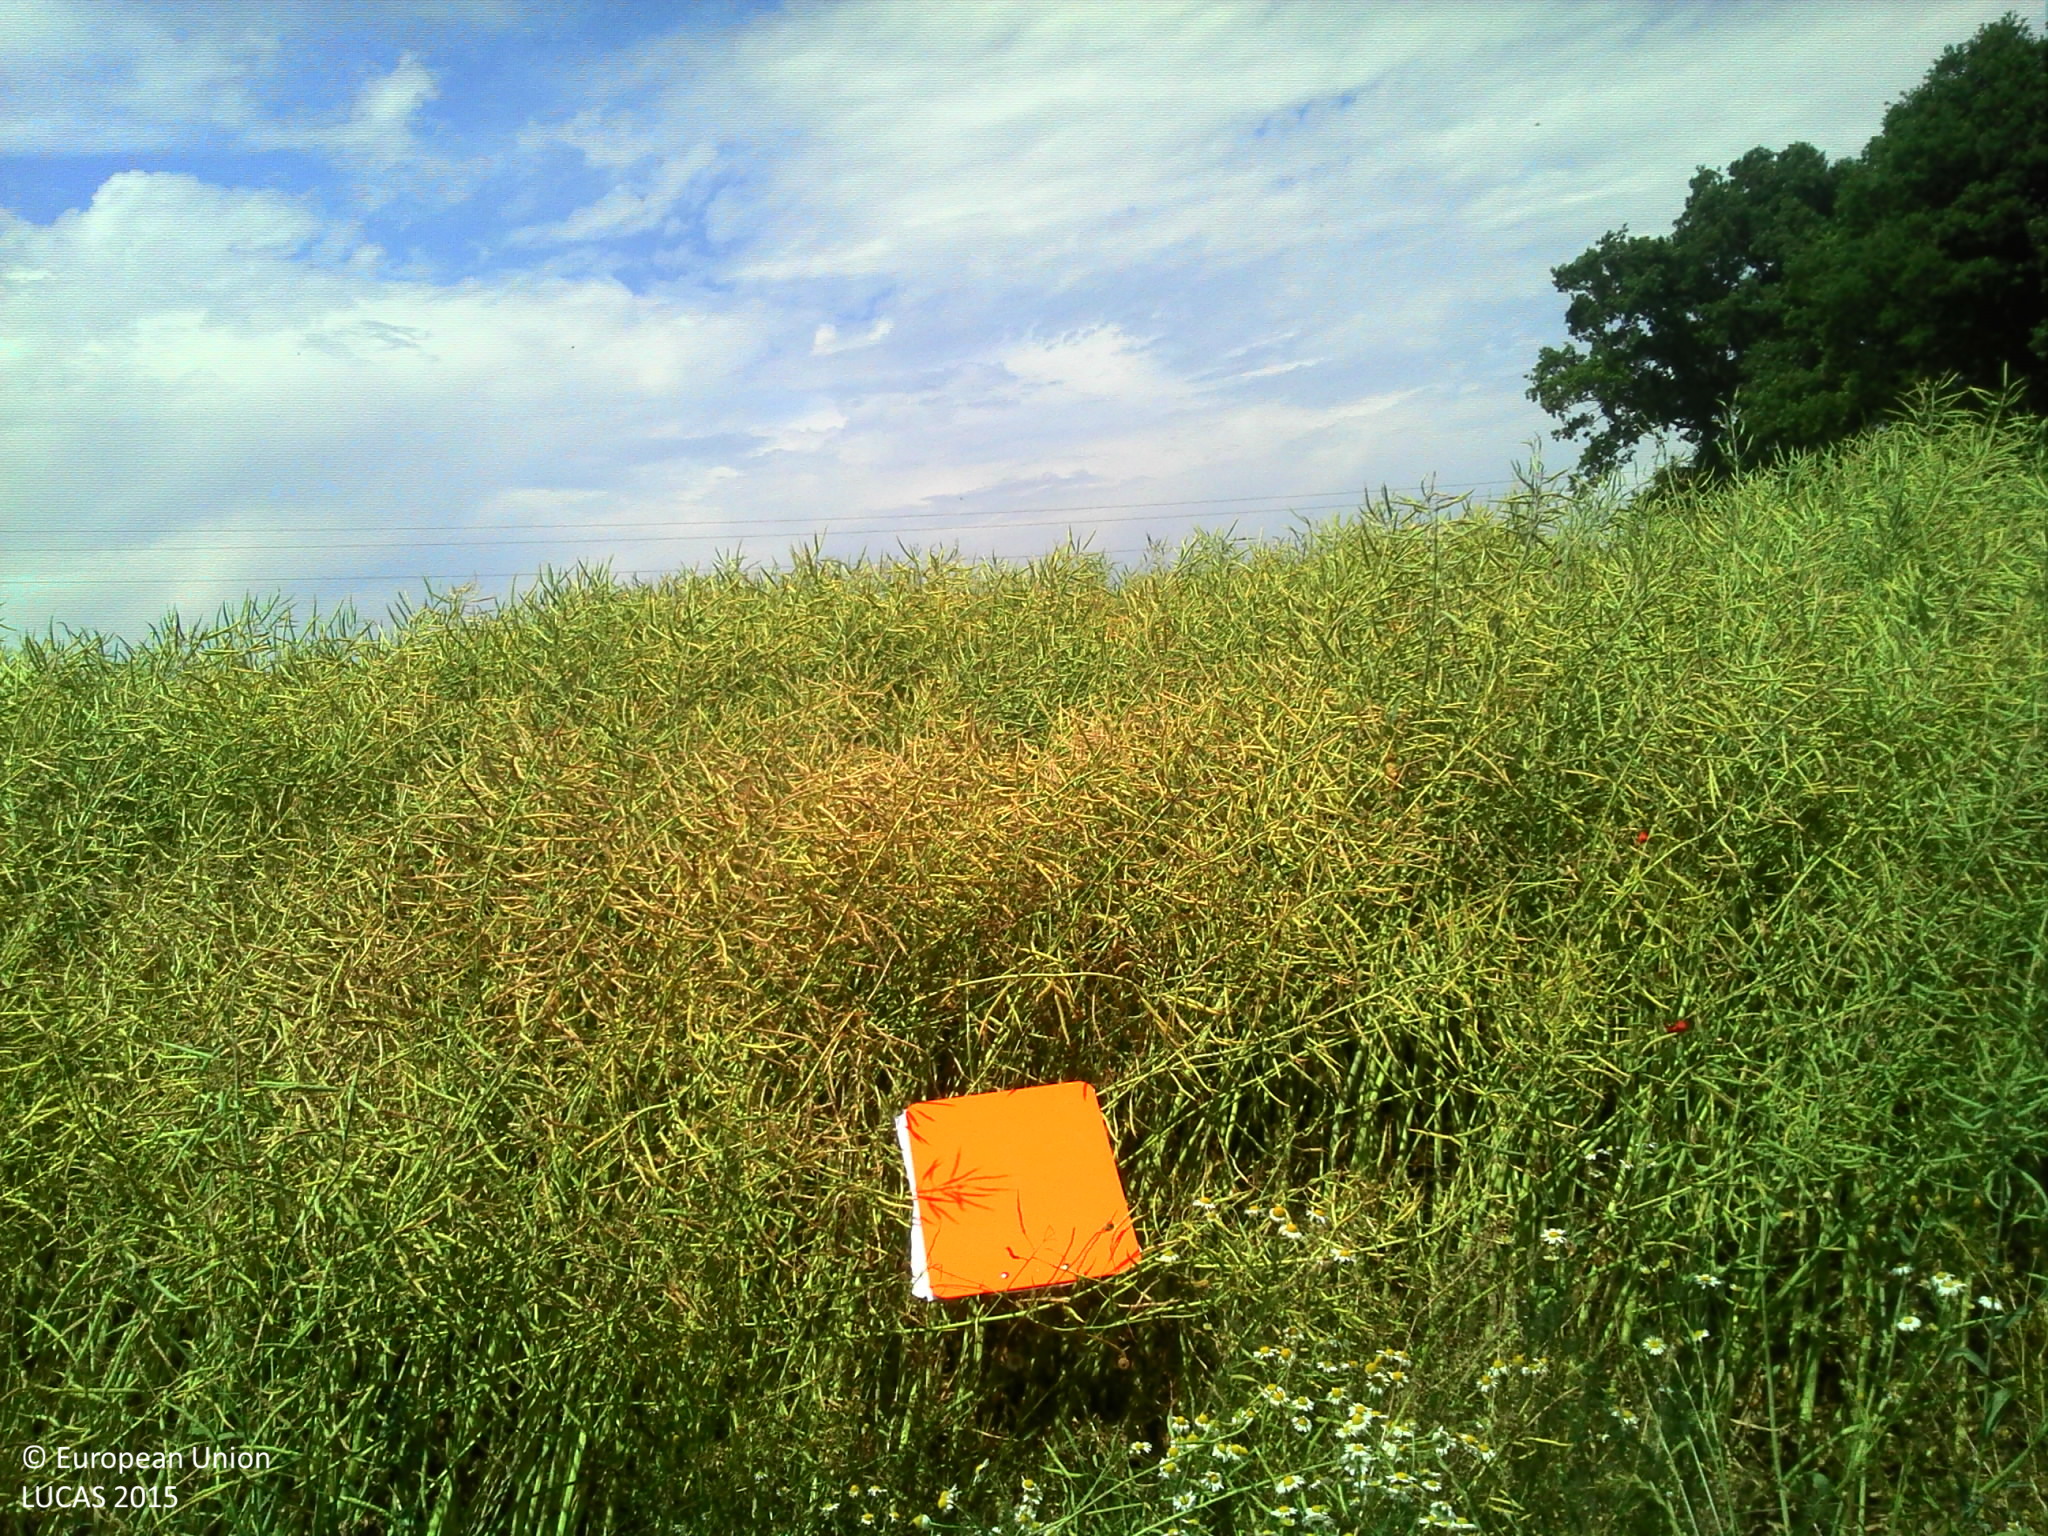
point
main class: Cropland
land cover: Rape and turnip rape
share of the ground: > 75 %
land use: Agriculture (excluding fallow land and kitchen gardens)
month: June
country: FR
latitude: 49.0682
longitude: 1.2338
